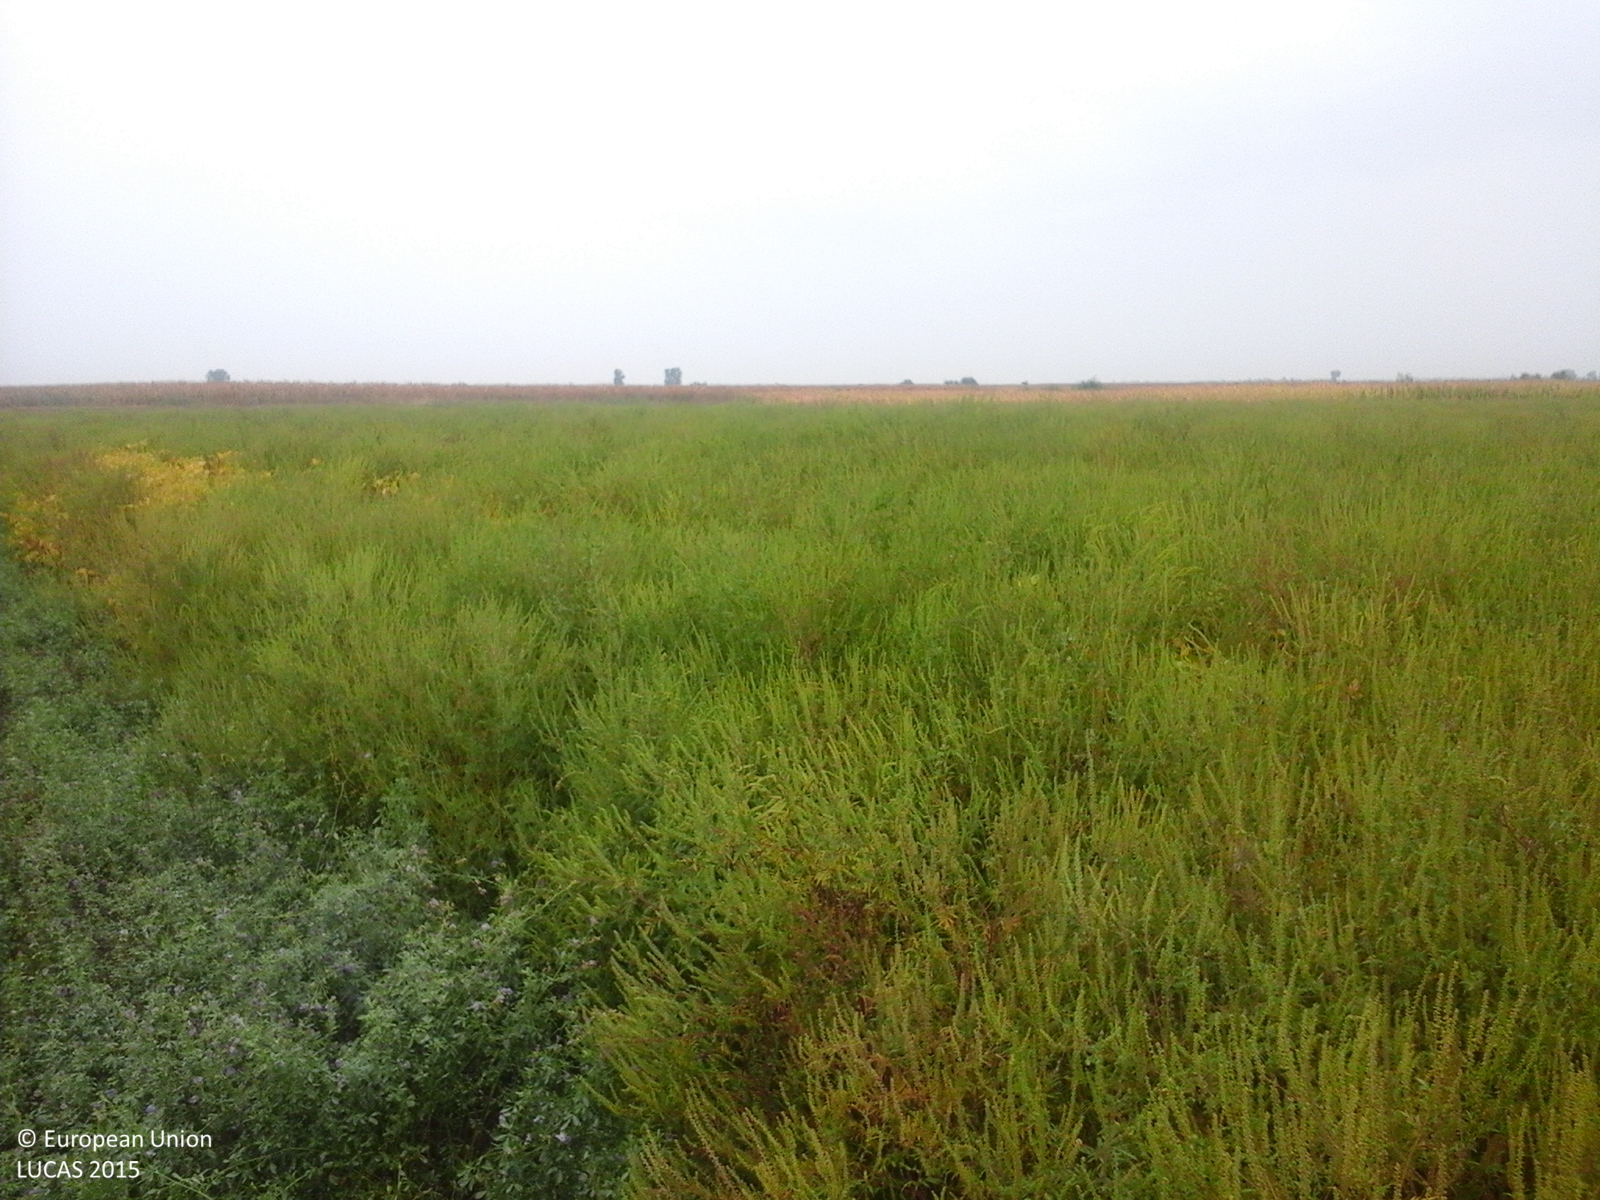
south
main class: Cropland
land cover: Soya
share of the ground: > 75 %
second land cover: Spontaneously vegetated surfaces
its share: > 75 %
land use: Agriculture (excluding fallow land and kitchen gardens)
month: September
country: RO
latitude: 47.7806
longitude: 22.5107
